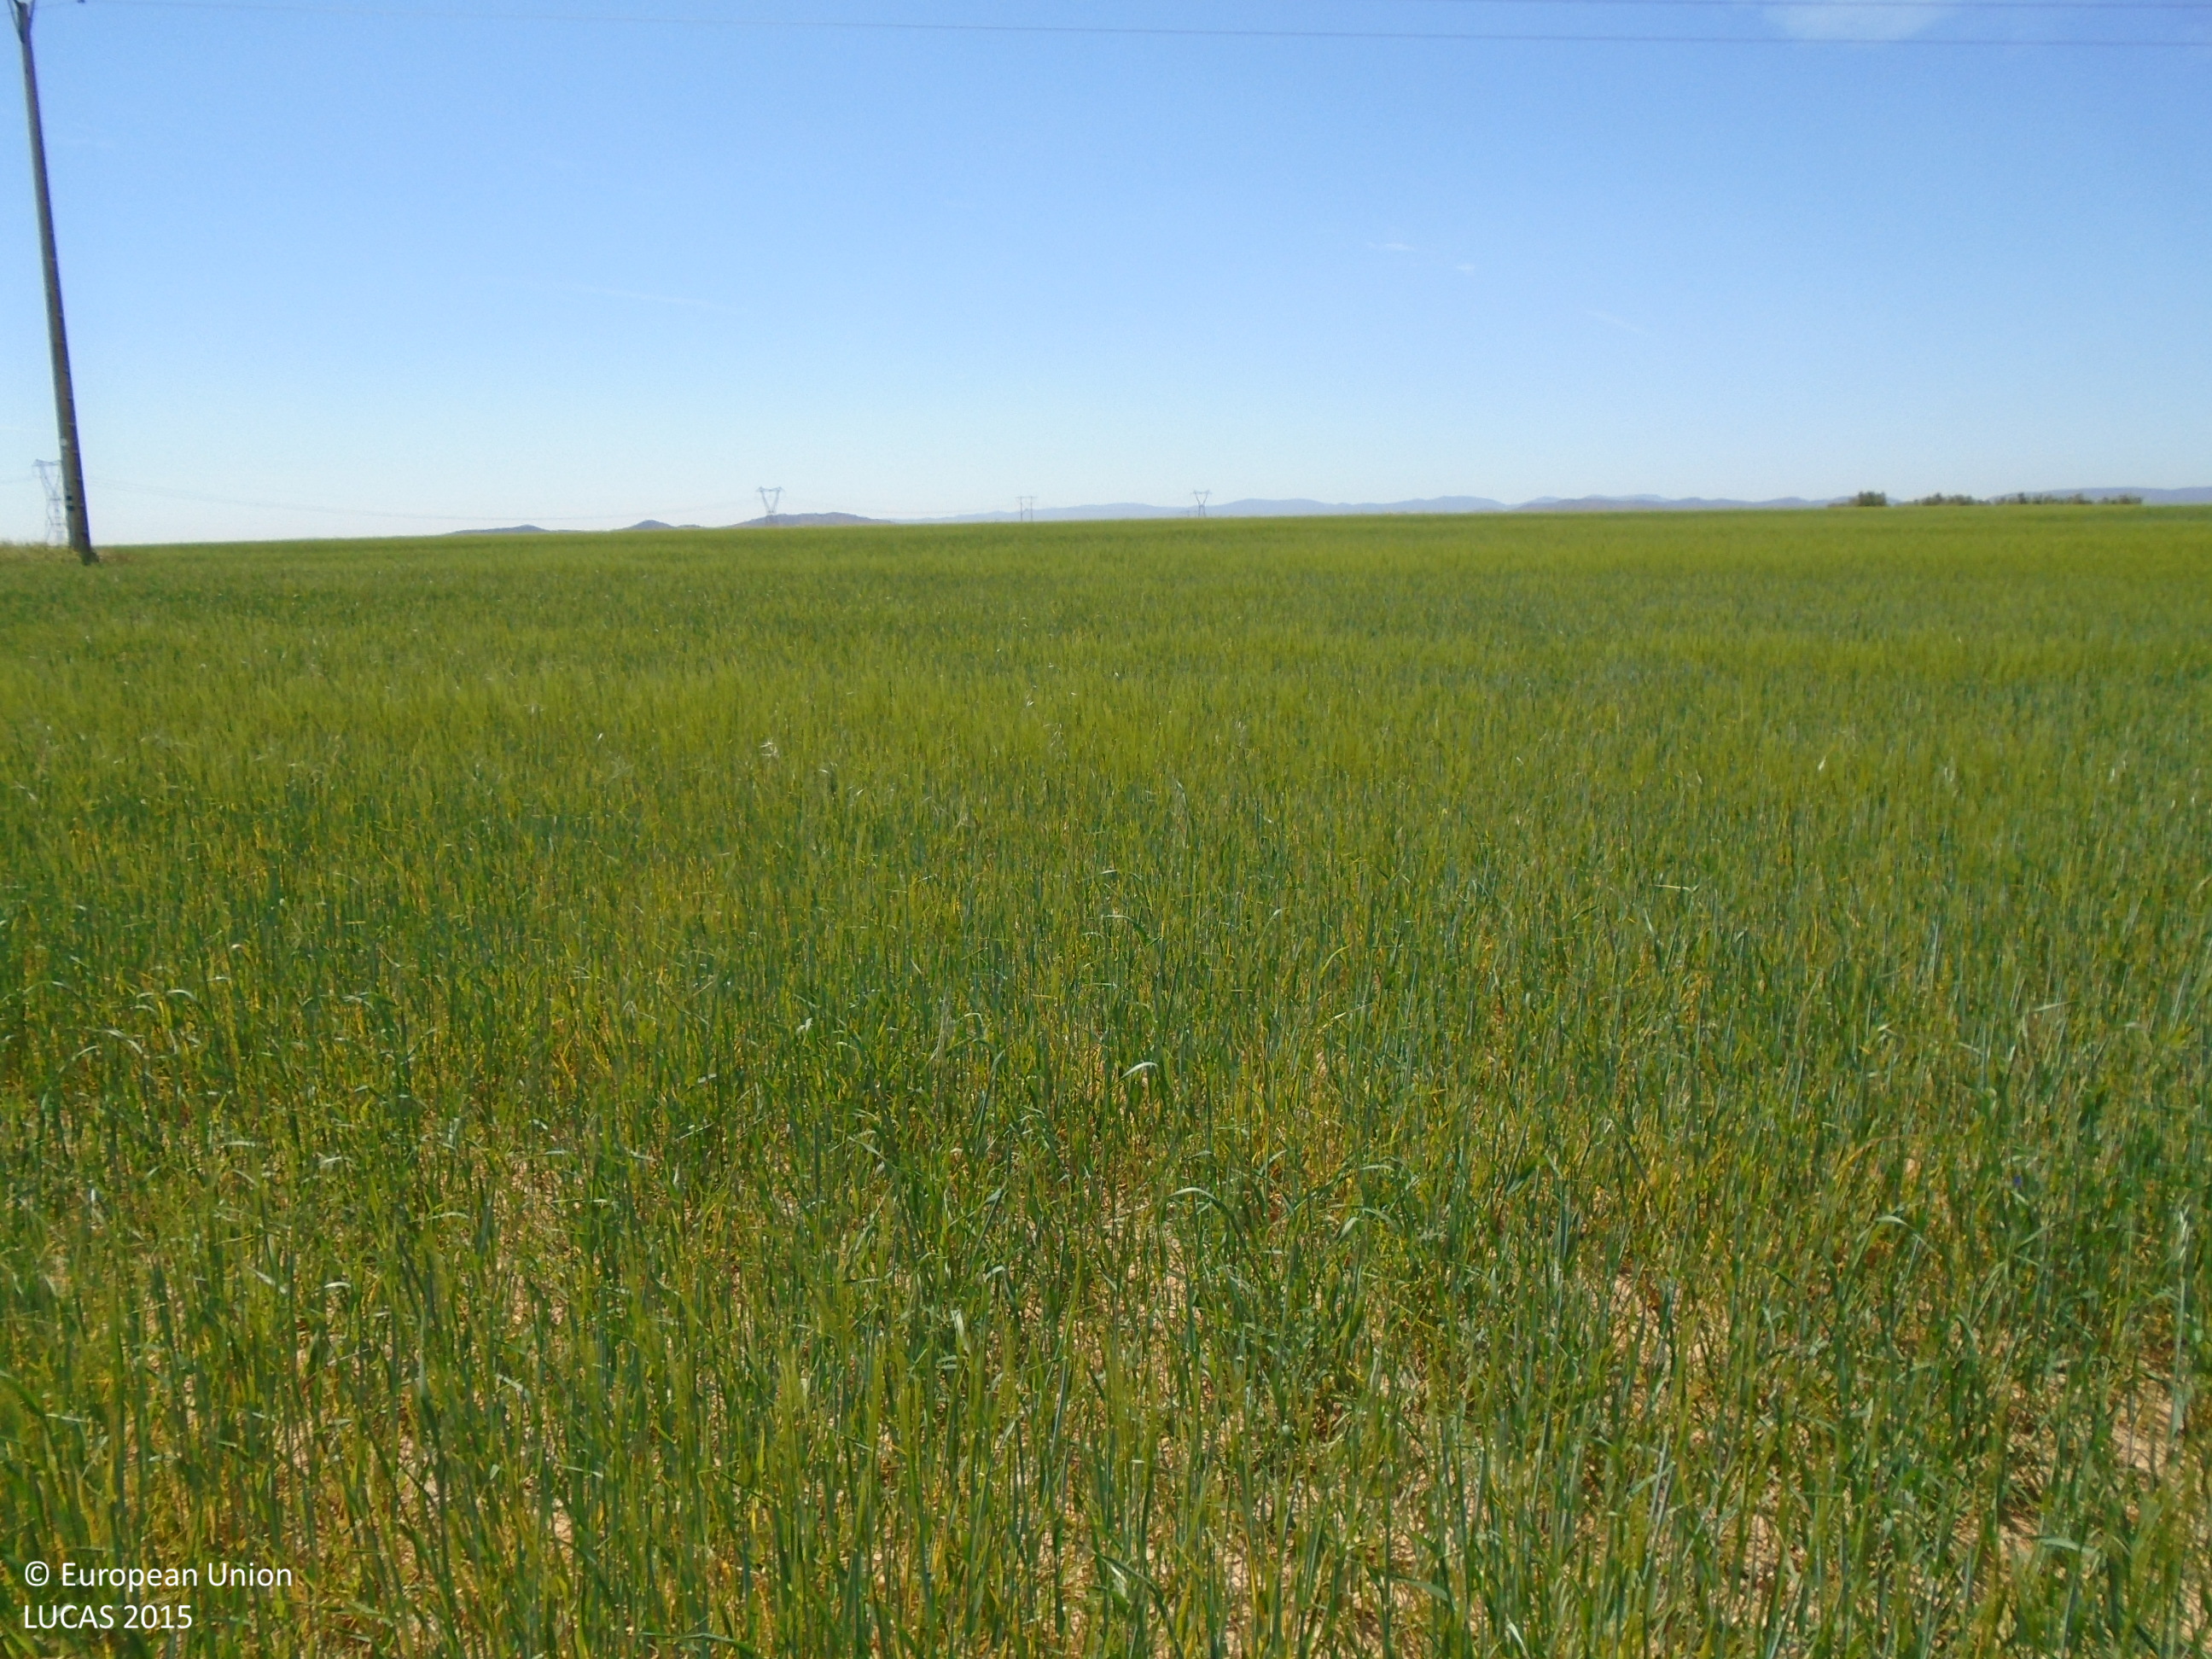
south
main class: Cropland
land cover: Barley
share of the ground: > 75 %
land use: Agriculture (excluding fallow land and kitchen gardens)
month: May
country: ES
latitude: 39.6029
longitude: -3.6401
